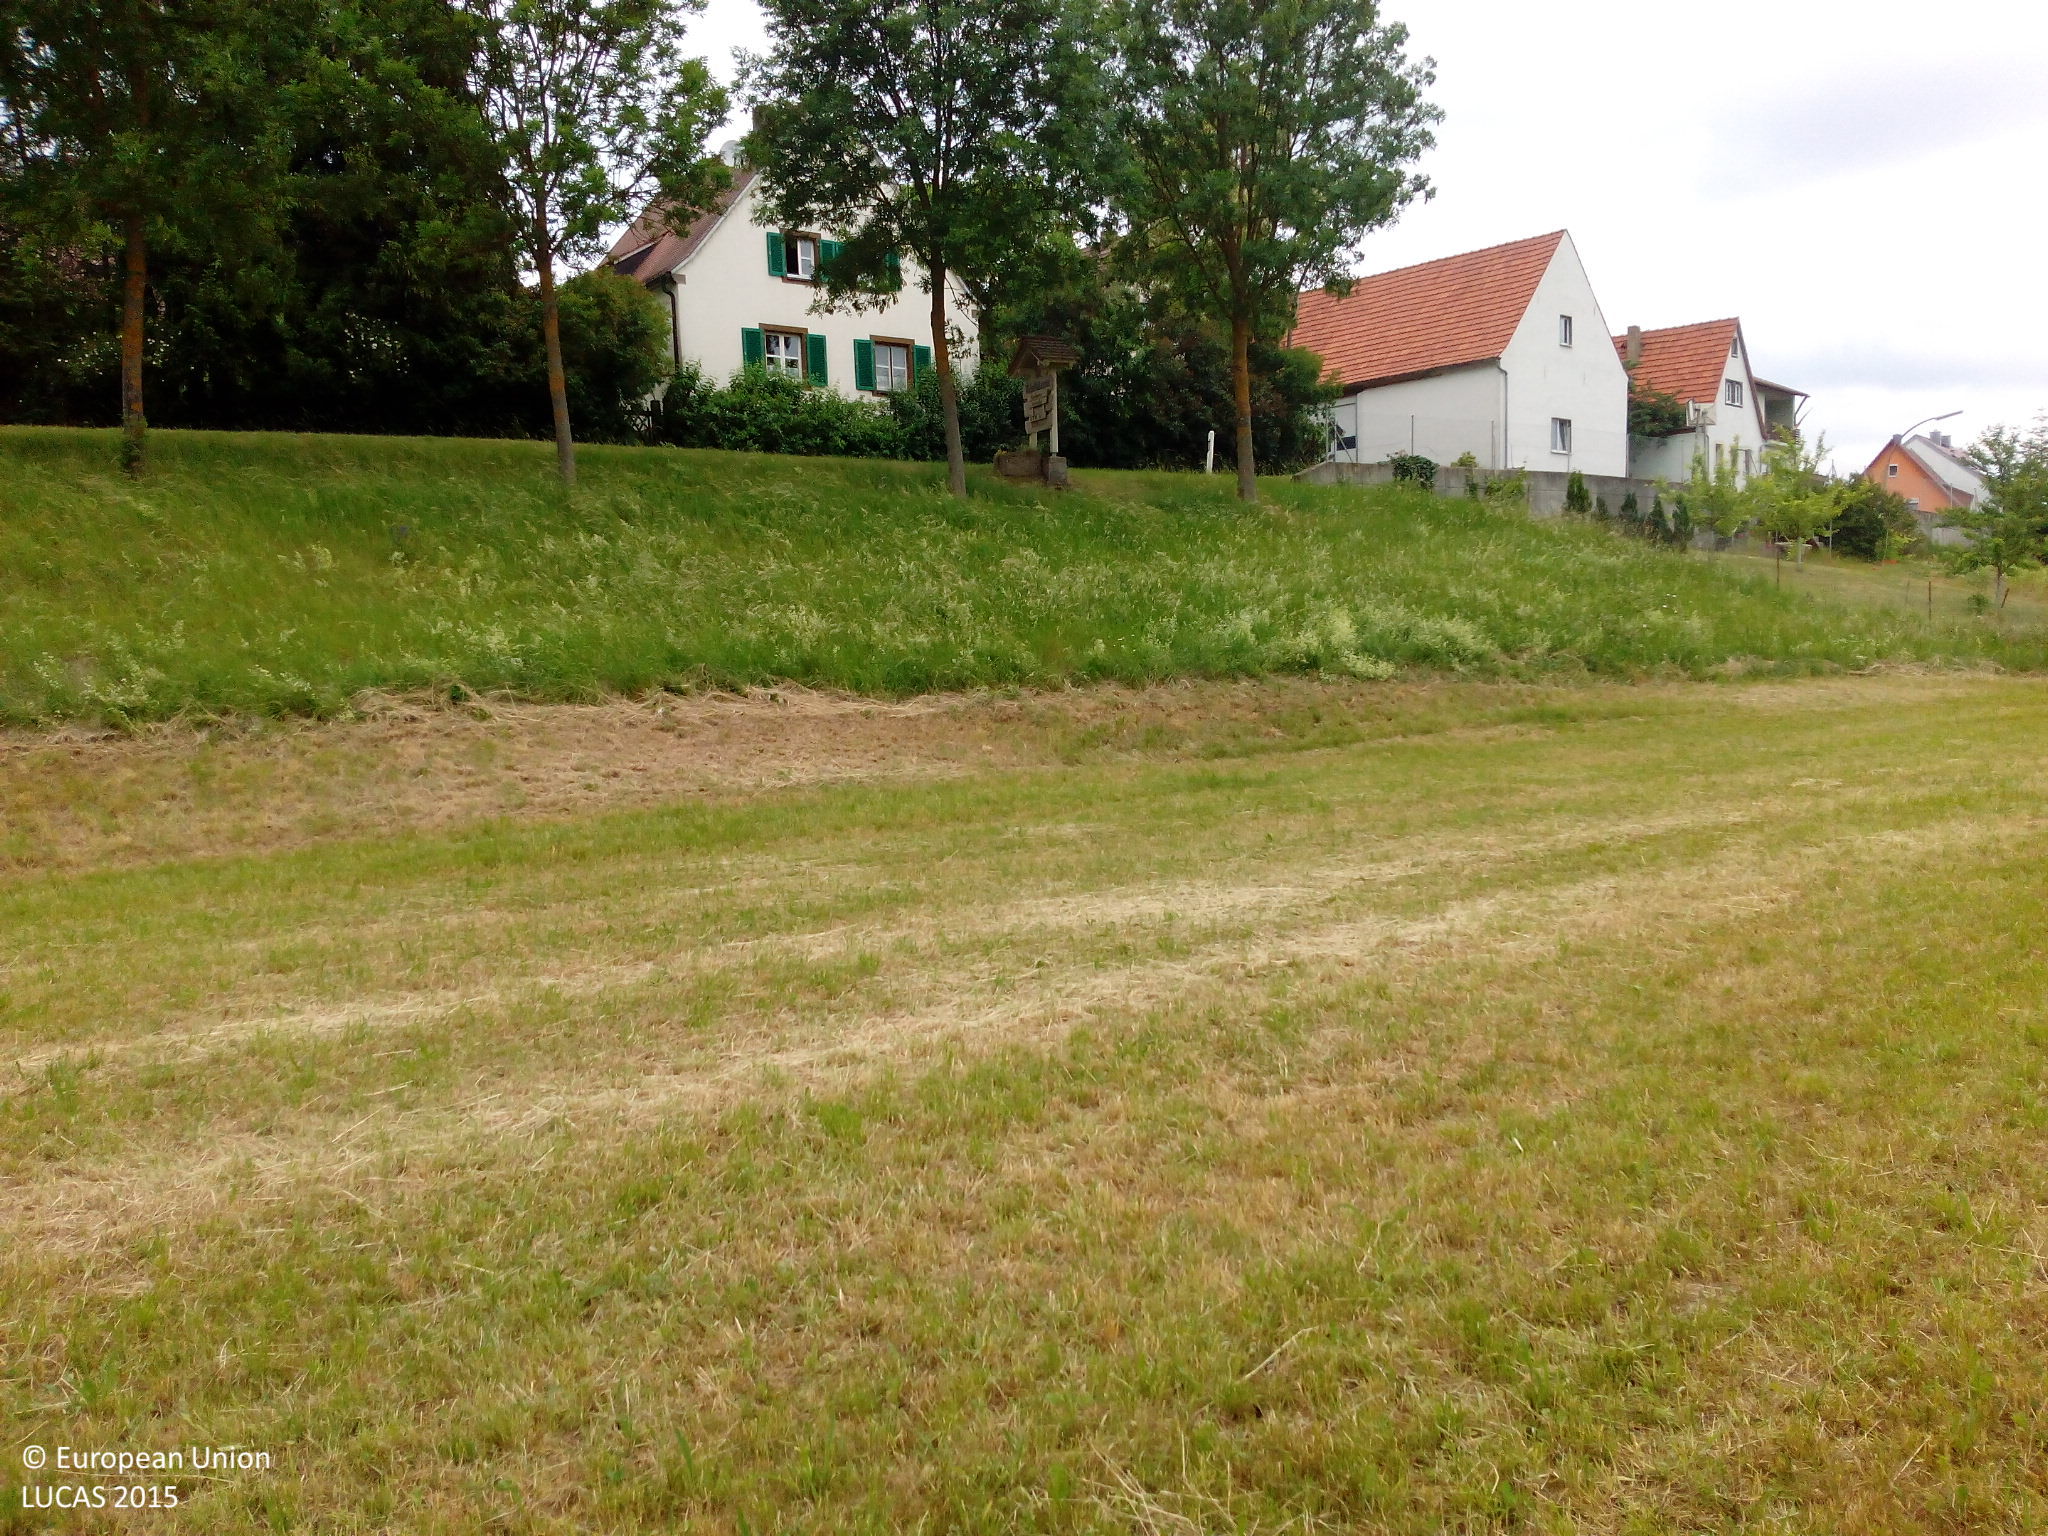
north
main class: Grassland
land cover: Grassland without tree/shrub cover
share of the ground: > 75 %
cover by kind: herbaceous plants 100 %
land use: Agriculture (excluding fallow land and kitchen gardens)
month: June
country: DE
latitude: 50.1120
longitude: 10.2656
